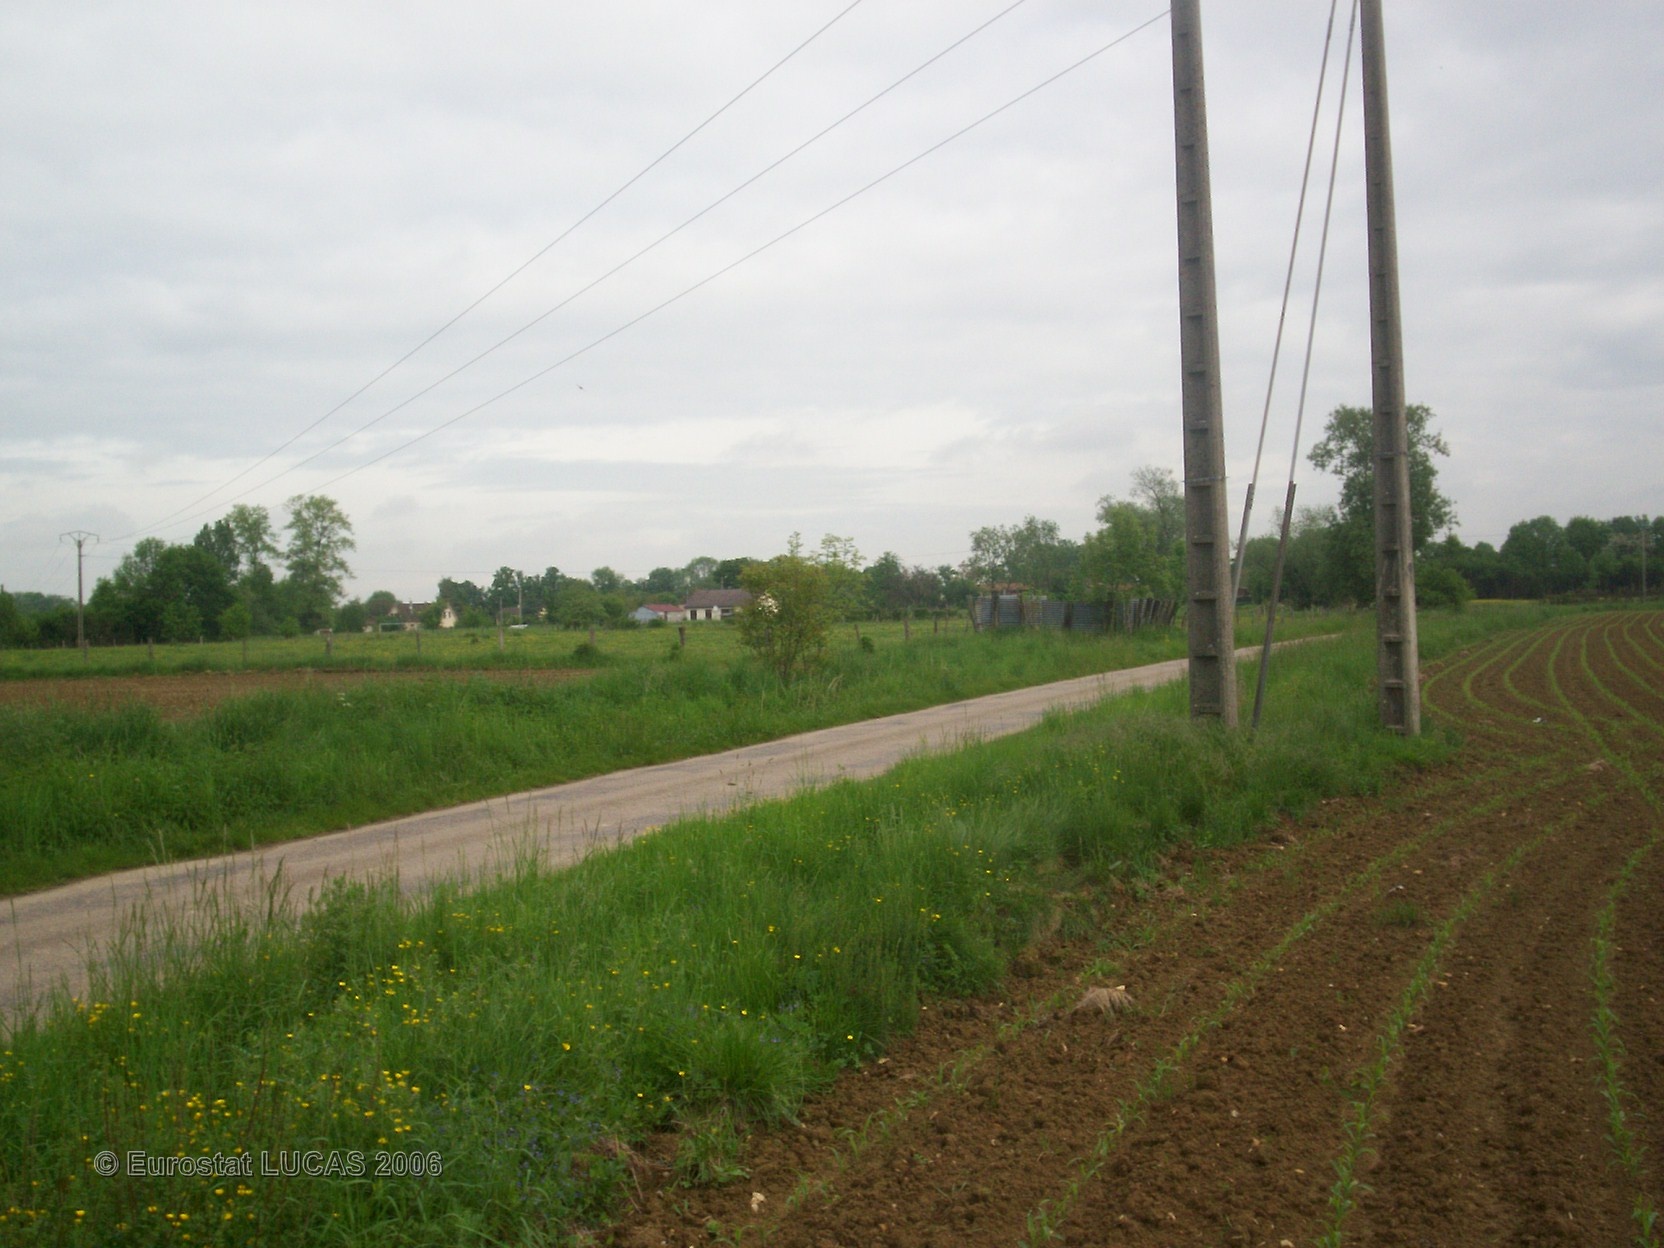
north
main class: Cropland
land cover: Maize
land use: Agriculture (excluding fallow land and kitchen gardens)
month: May
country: FR
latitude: 48.6263
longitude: 4.8559
